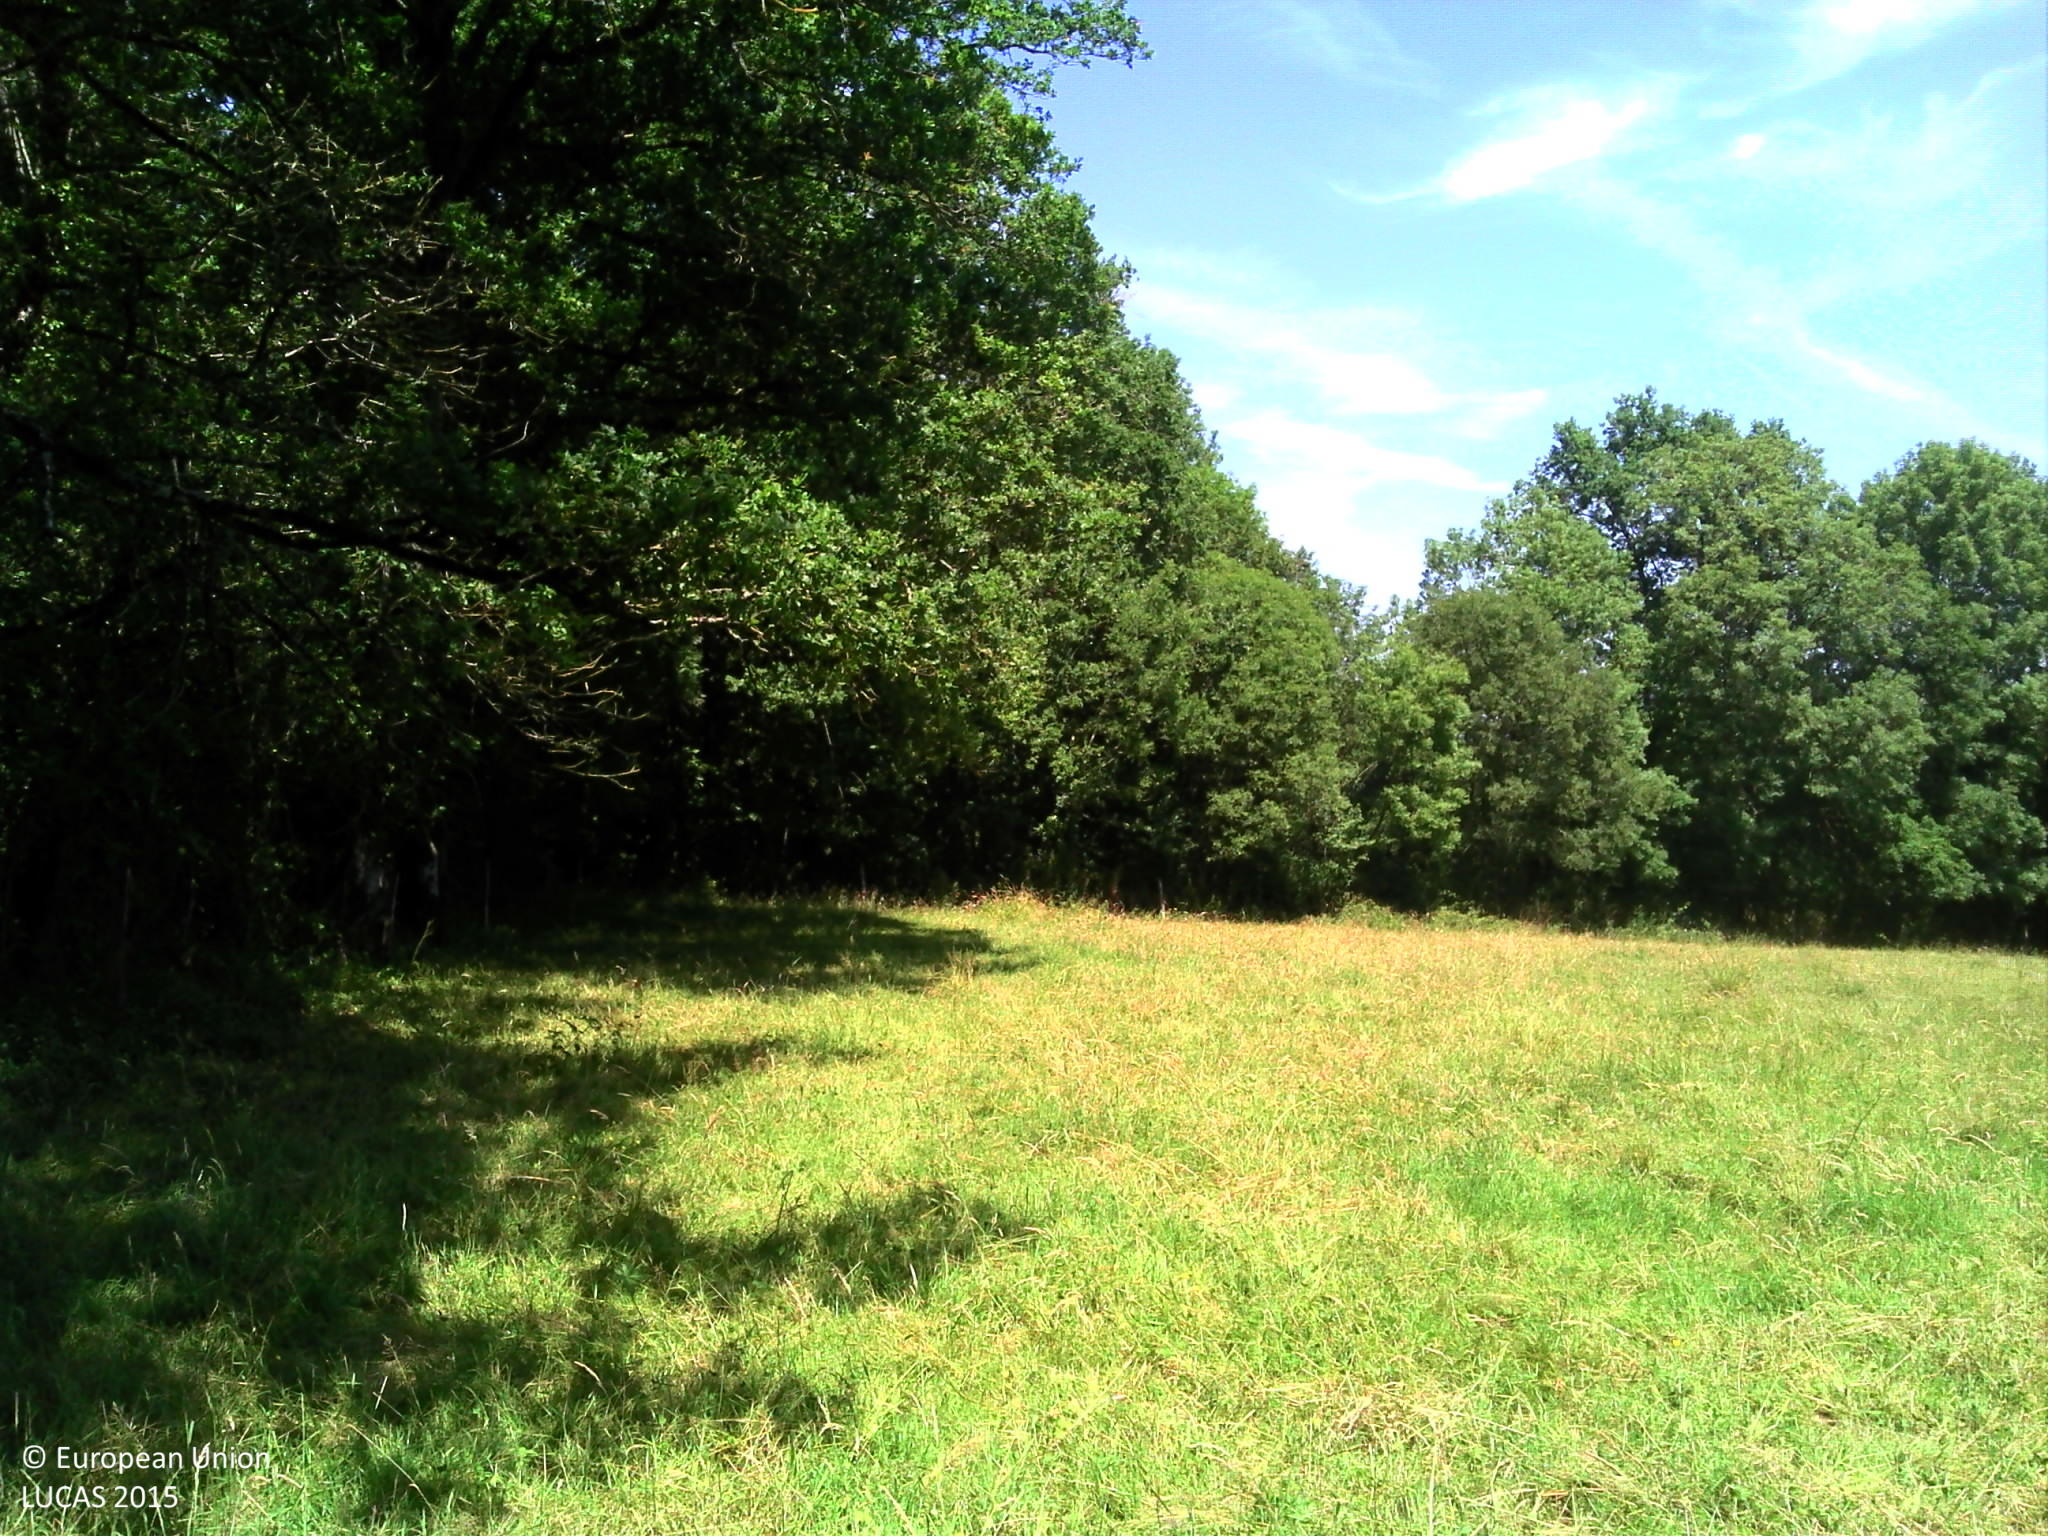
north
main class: Grassland
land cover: Grassland without tree/shrub cover
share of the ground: > 75 %
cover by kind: herbaceous plants 100 %
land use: Agriculture (excluding fallow land and kitchen gardens)
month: June
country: FR
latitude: 45.8278
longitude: 0.6022
